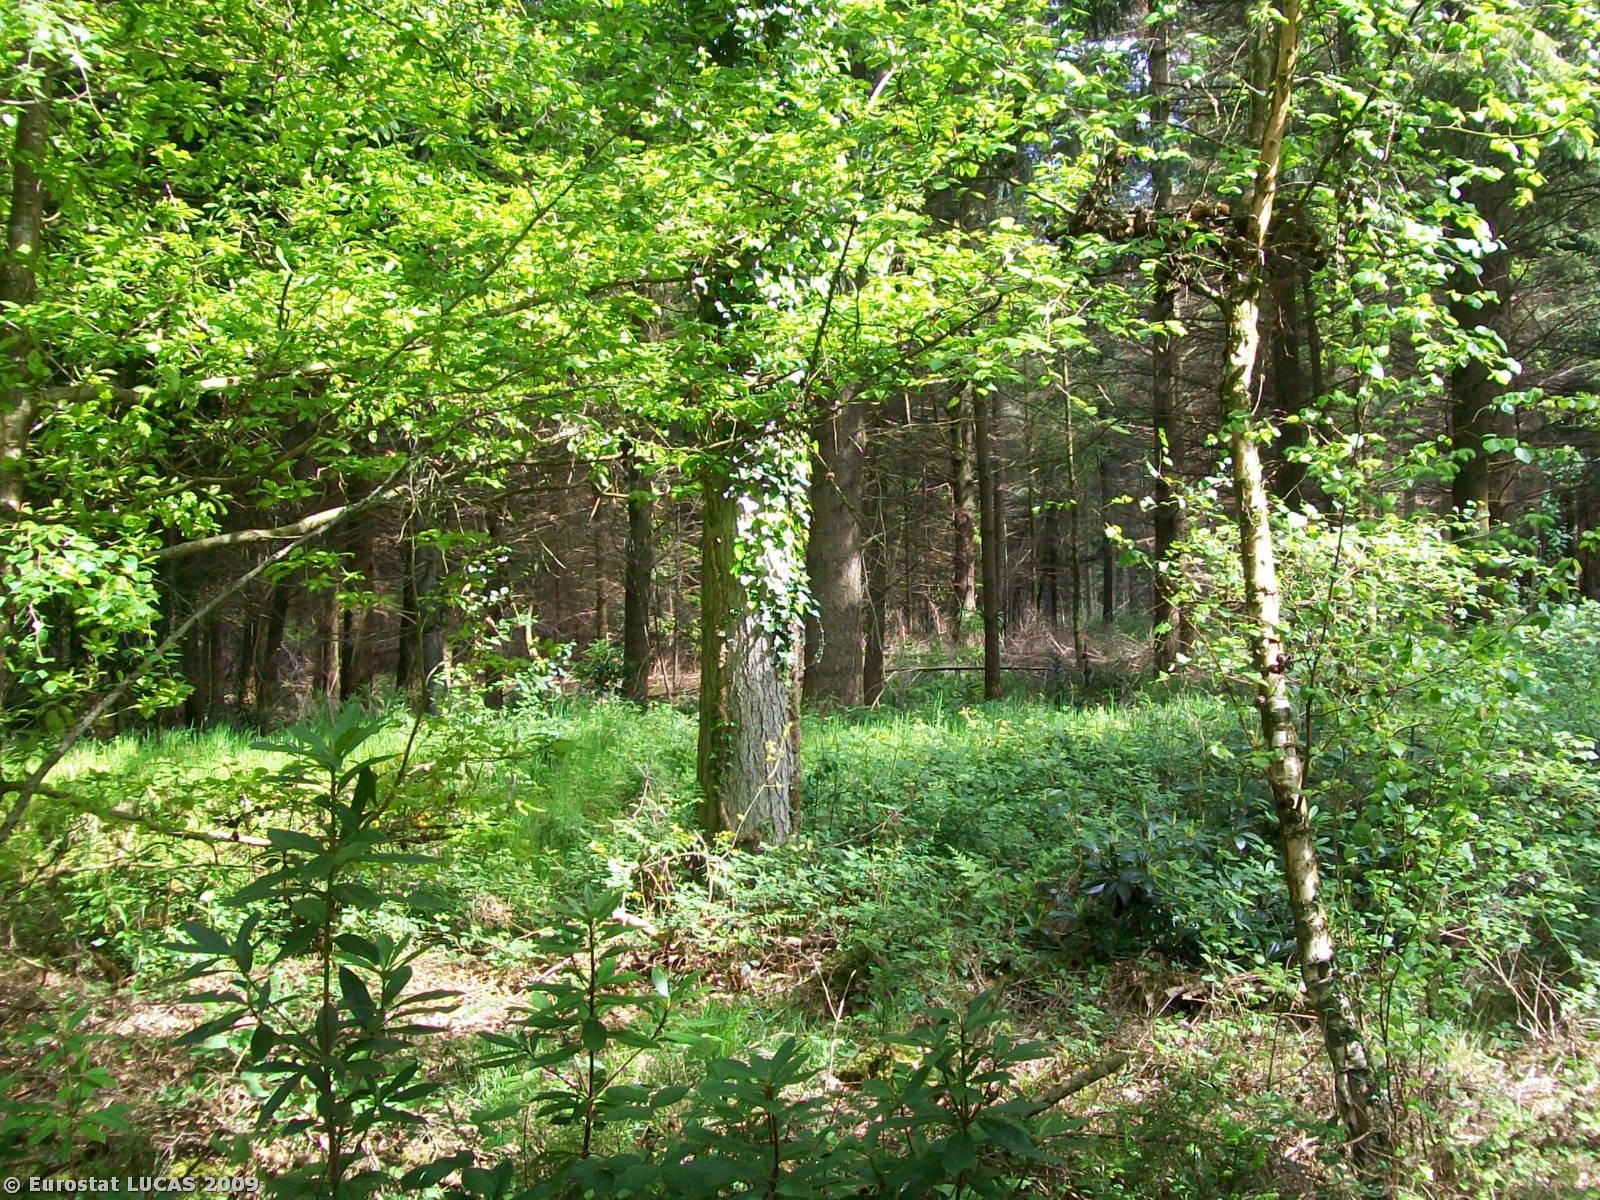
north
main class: Woodland
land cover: Coniferous woodland
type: plantations and self-sown exotic forest
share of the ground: 50 - 75 %
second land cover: Spontaneously vegetated surfaces
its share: > 75 %
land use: Community services
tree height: > 5 m
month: May
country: GB
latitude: 51.1837
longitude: -2.1787
